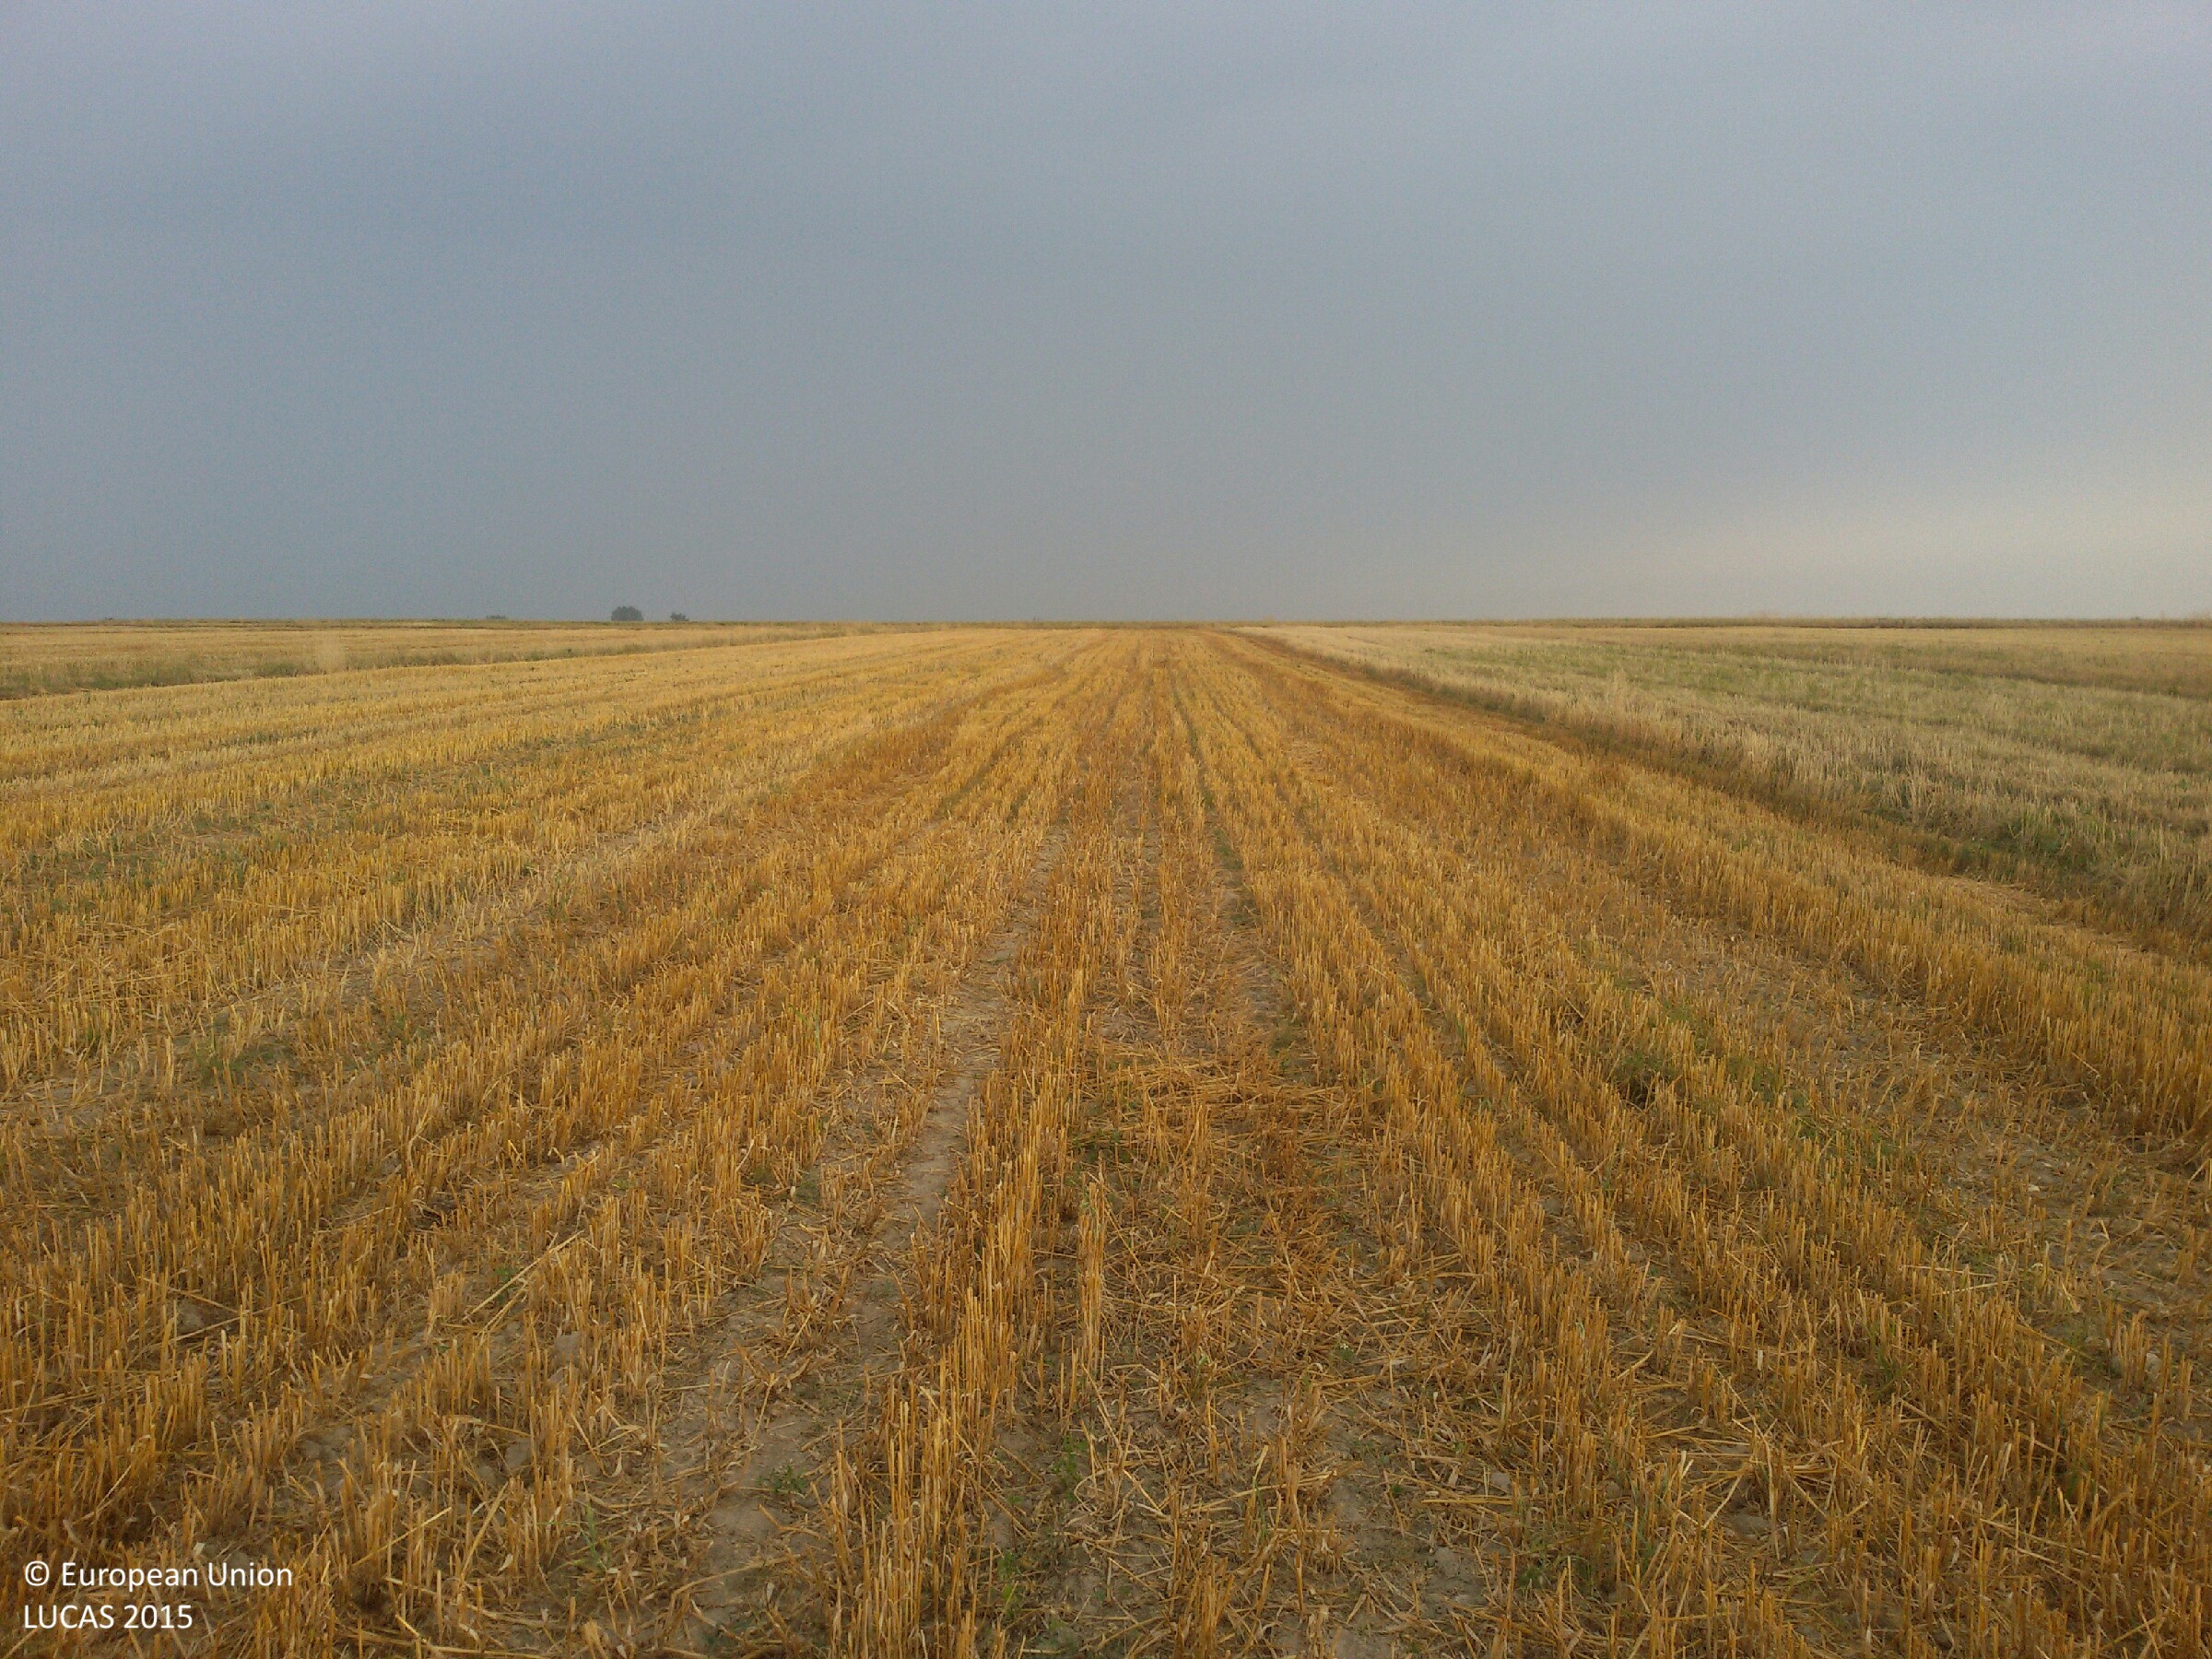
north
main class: Cropland
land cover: Oats
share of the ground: > 75 %
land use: Agriculture (excluding fallow land and kitchen gardens)
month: August
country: PL
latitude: 51.5213
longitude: 20.9832
